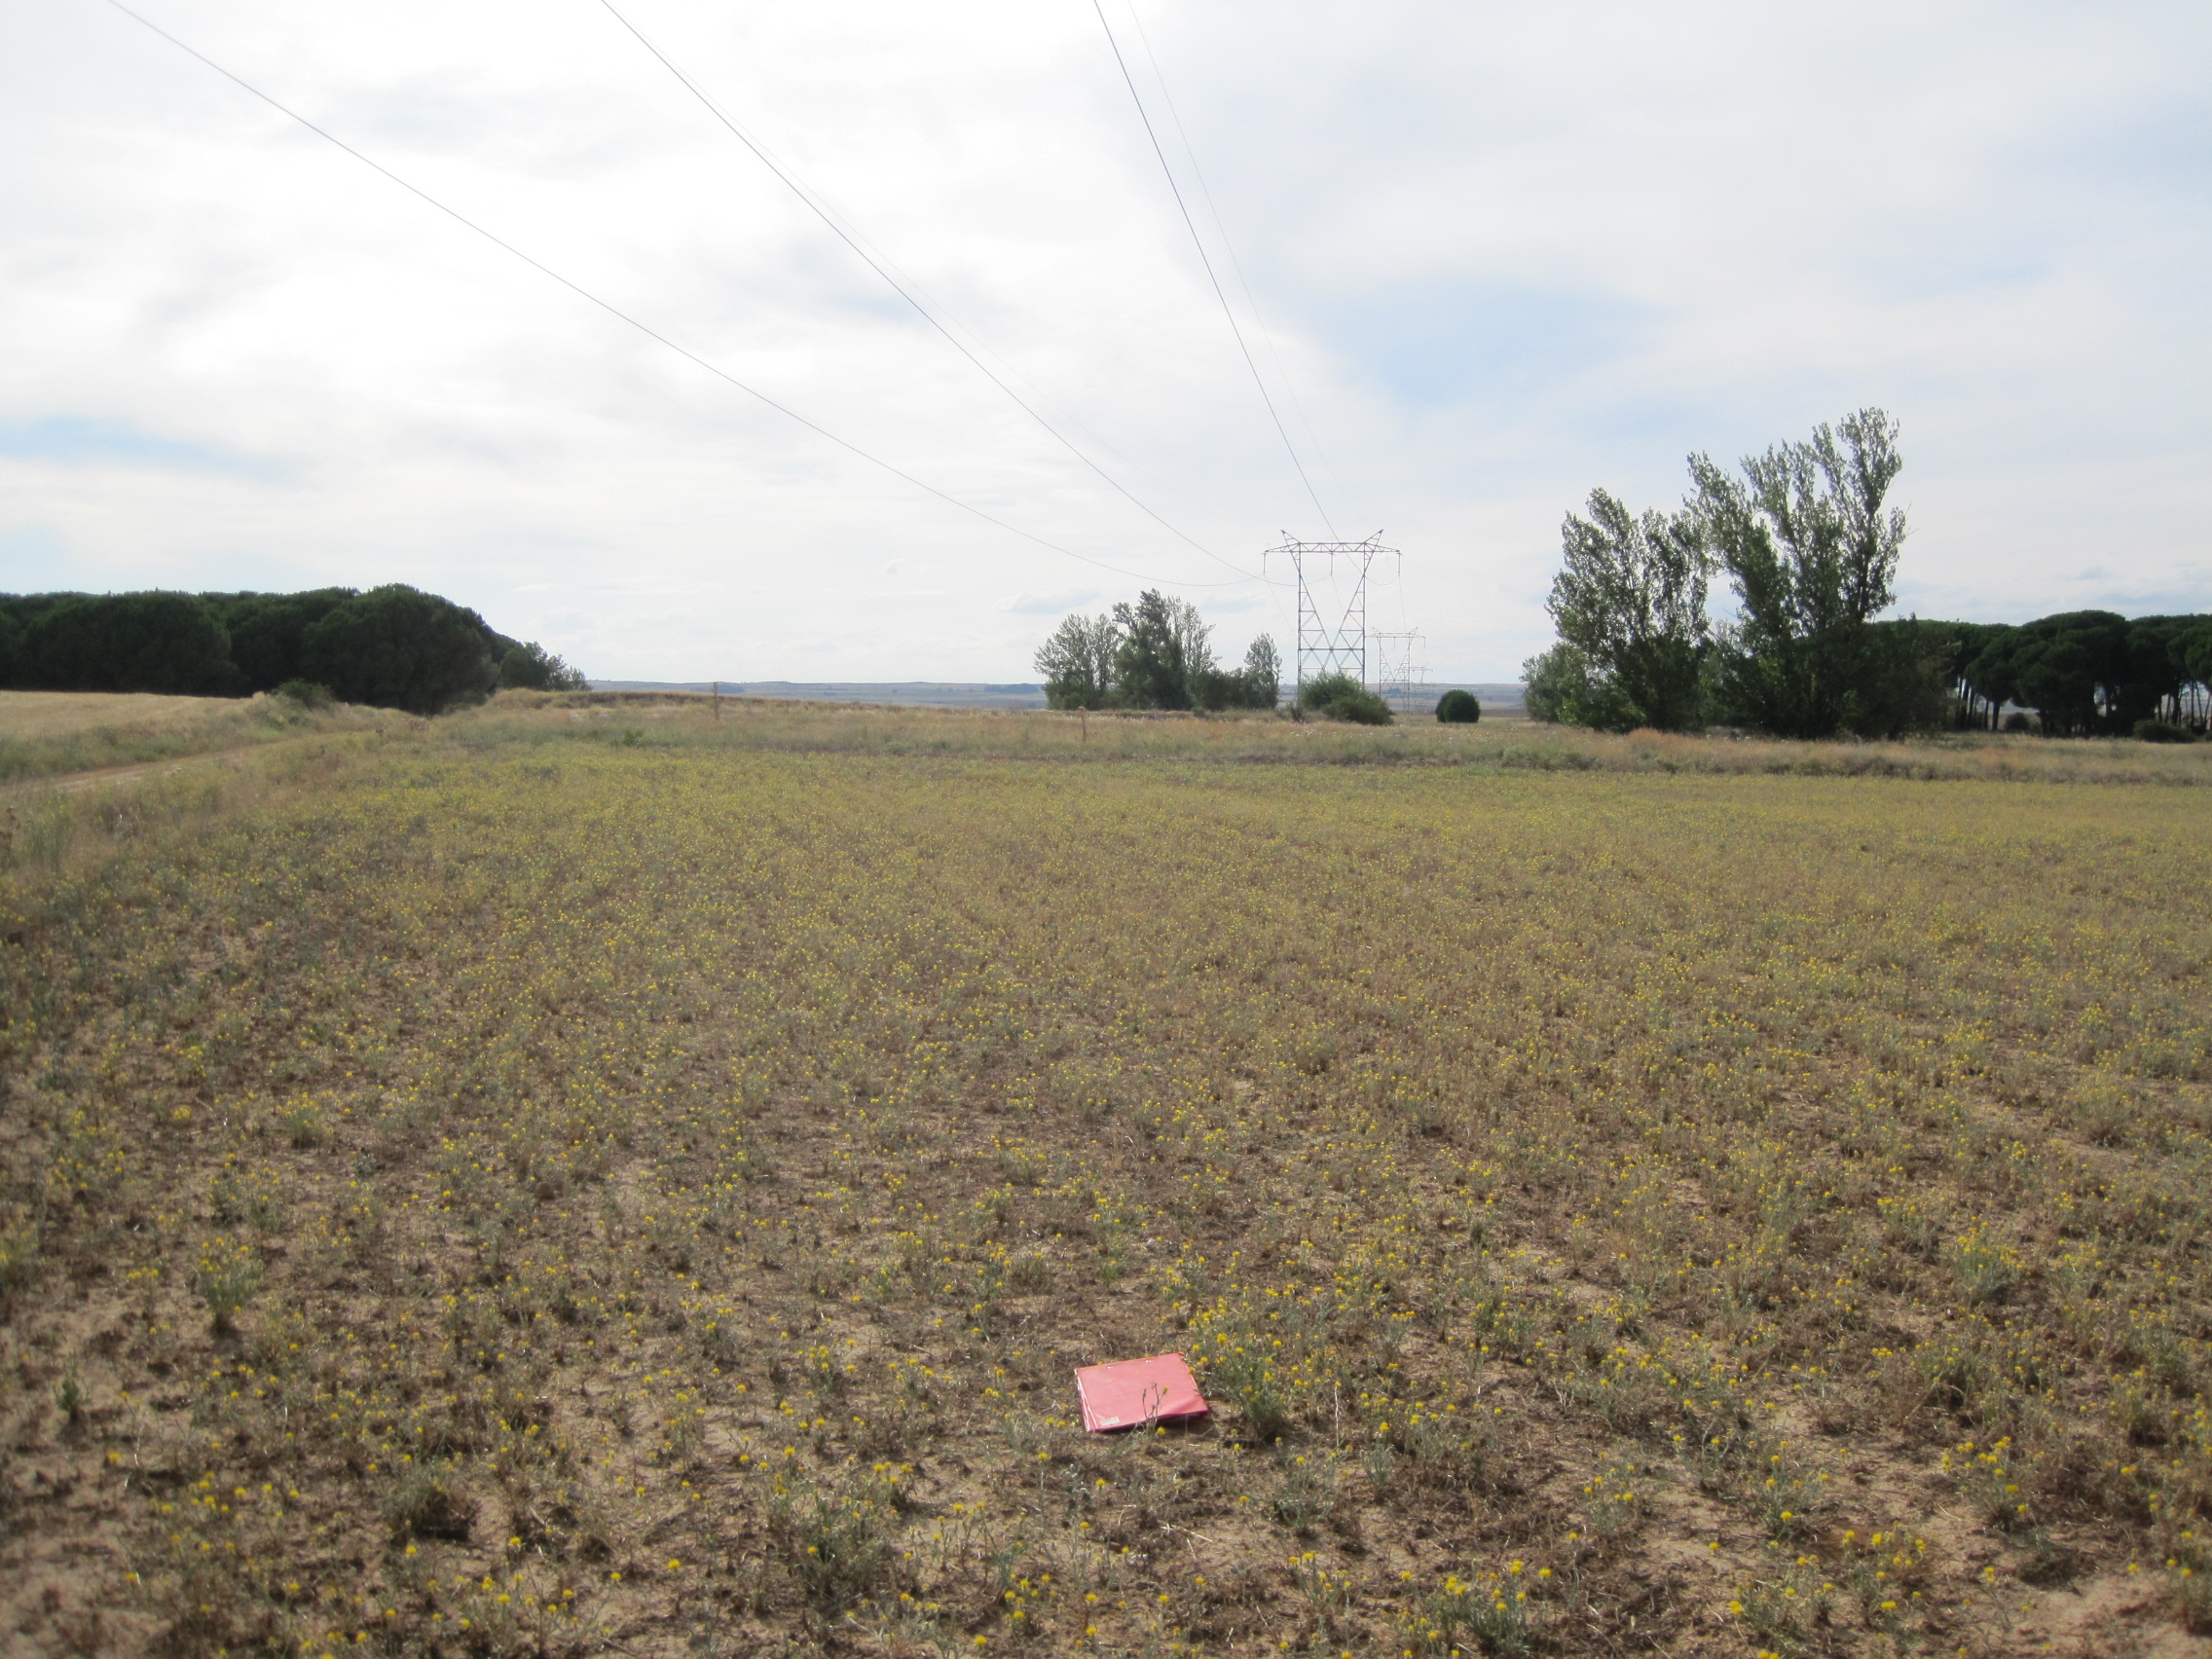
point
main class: Cropland
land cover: Dry pulses
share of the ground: < 10 %
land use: Agriculture (excluding fallow land and kitchen gardens)
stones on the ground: < 10 %
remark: Harvested field
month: July
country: ES
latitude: 41.9647
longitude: -5.2745
